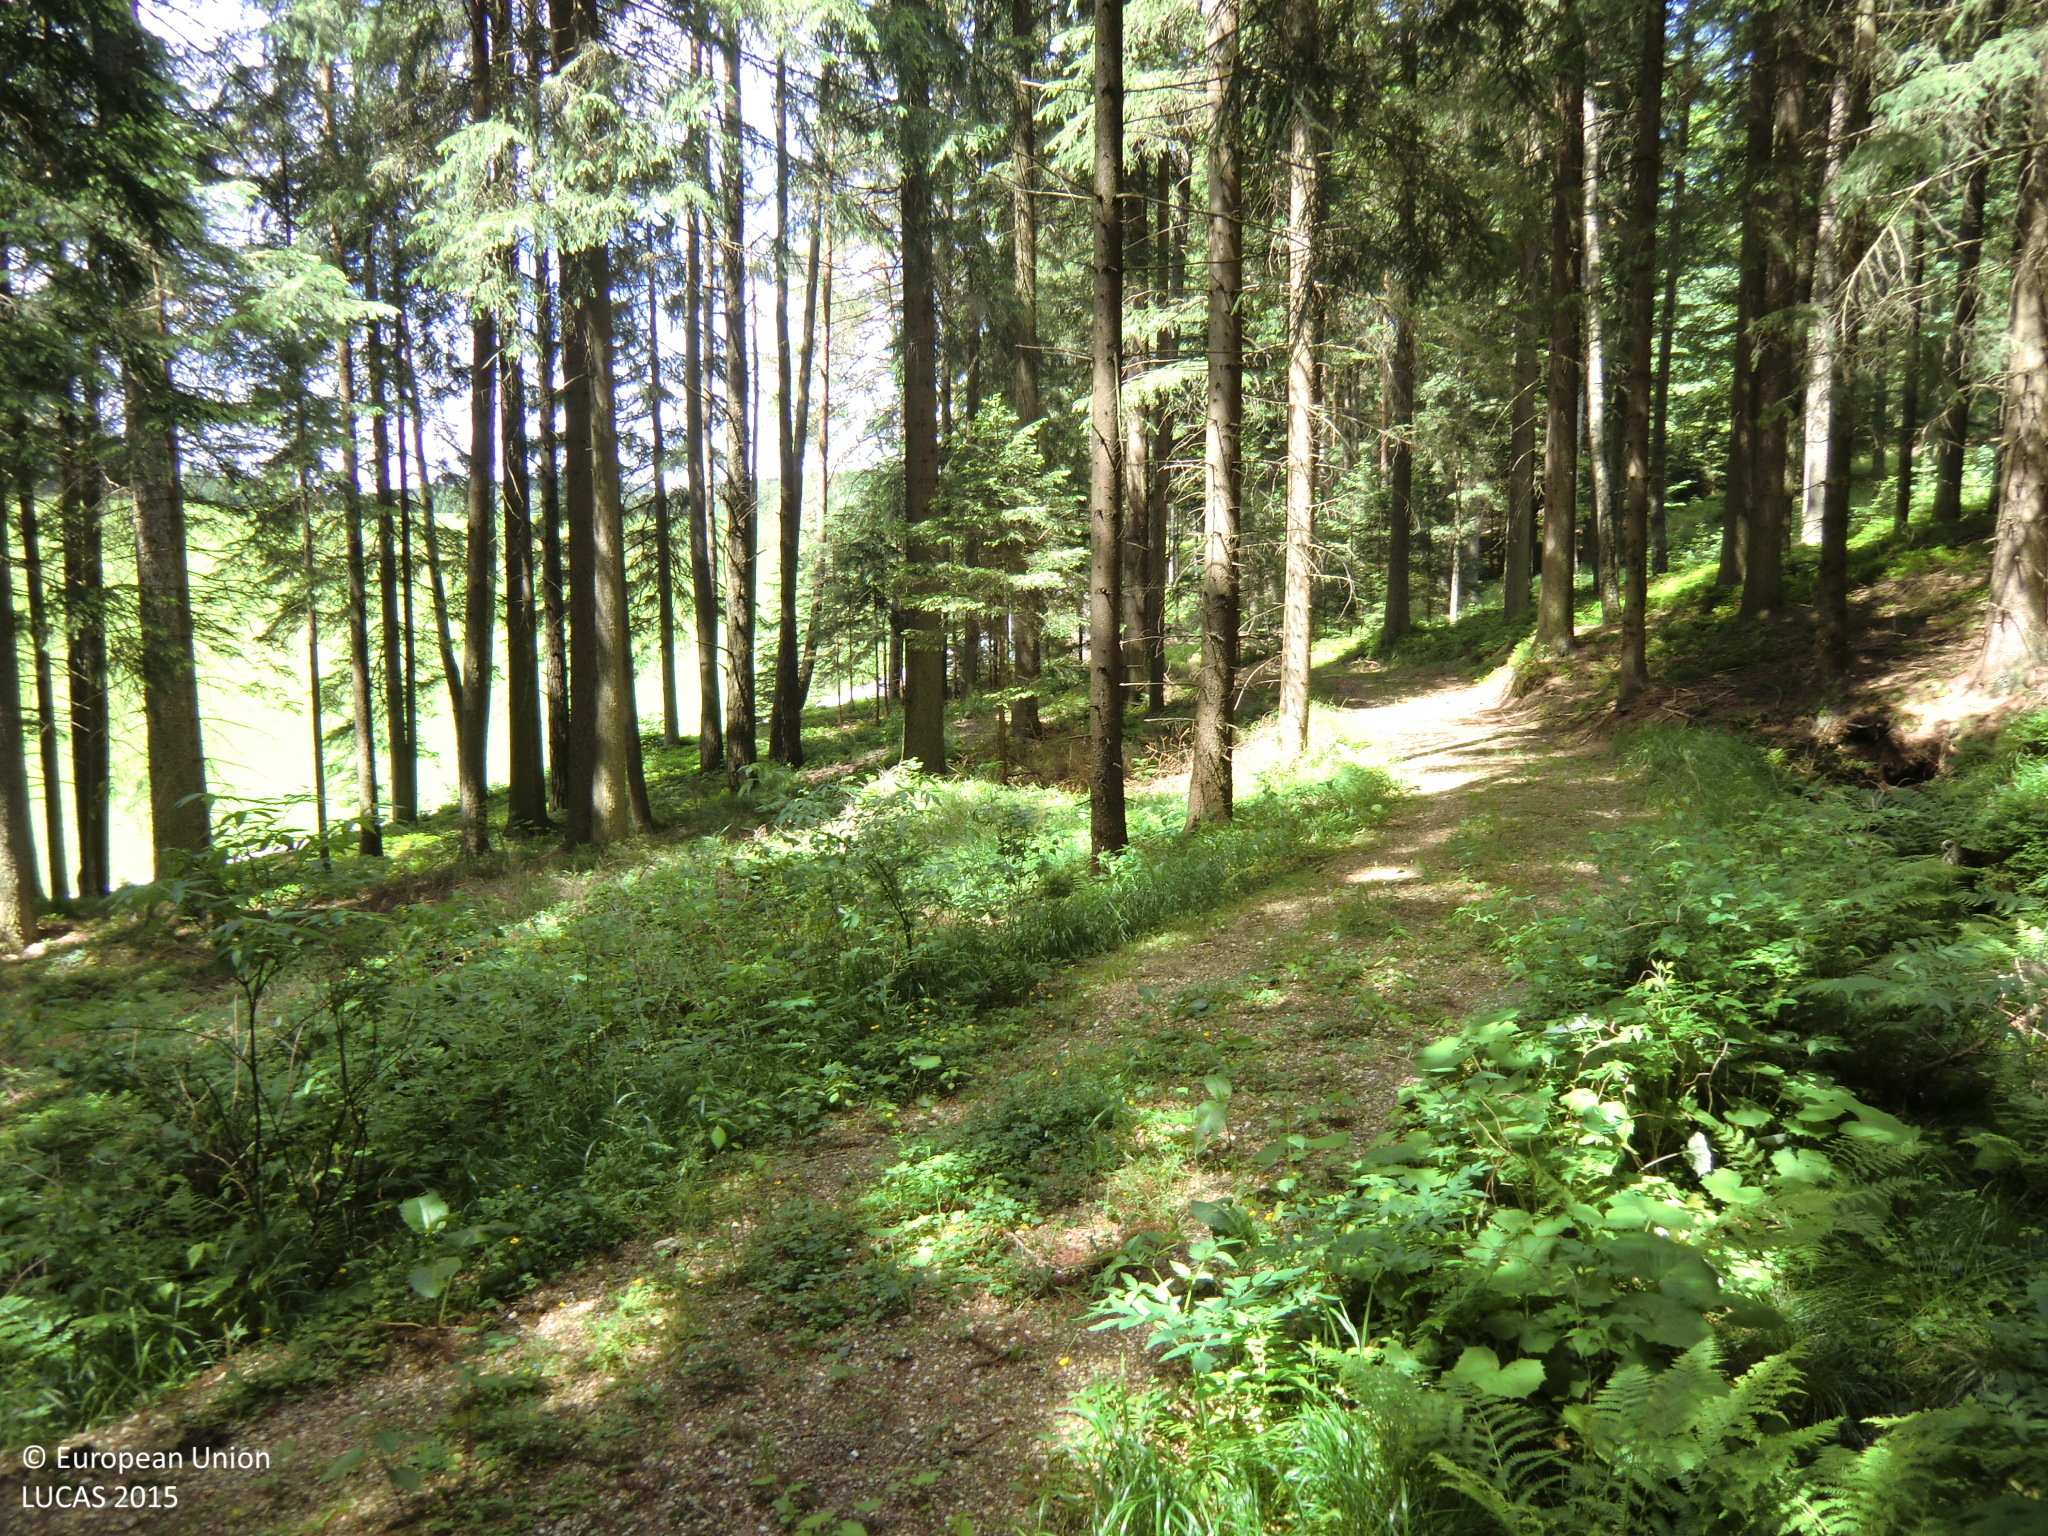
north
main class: Woodland
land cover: Spruce dominated coniferous woodland
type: hemiboreal forest and nemoral coniferous forest and mixed broadleaved-coniferous forest
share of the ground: > 75 %
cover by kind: coniferous forest trees 80 %, shrubs 10 %, herbaceous plants 10 %
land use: Forestry
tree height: > 5 m
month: June
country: AT
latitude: 48.5309
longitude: 14.8629
